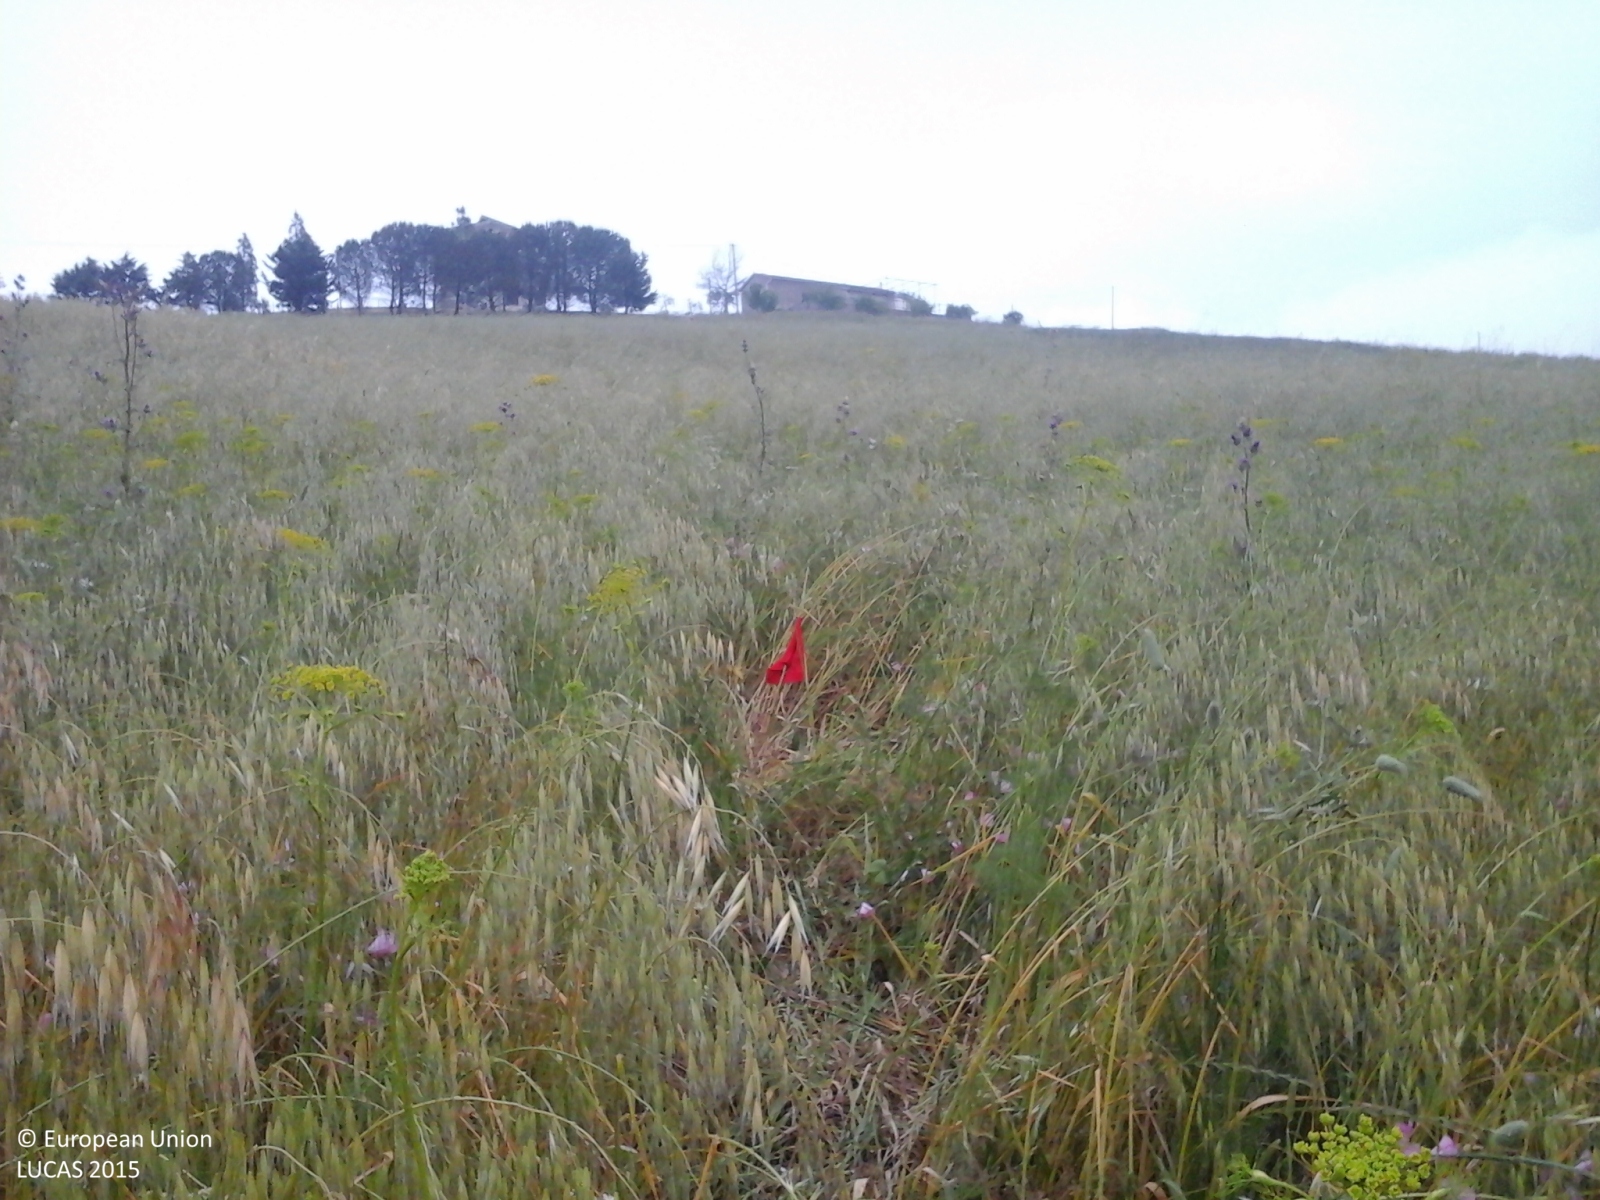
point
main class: Grassland
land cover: Spontaneously vegetated surfaces
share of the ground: > 75 %
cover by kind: herbaceous plants 100 %
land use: Fallow land
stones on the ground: < 10 %
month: May
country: IT
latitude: 37.7561
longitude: 13.9554
